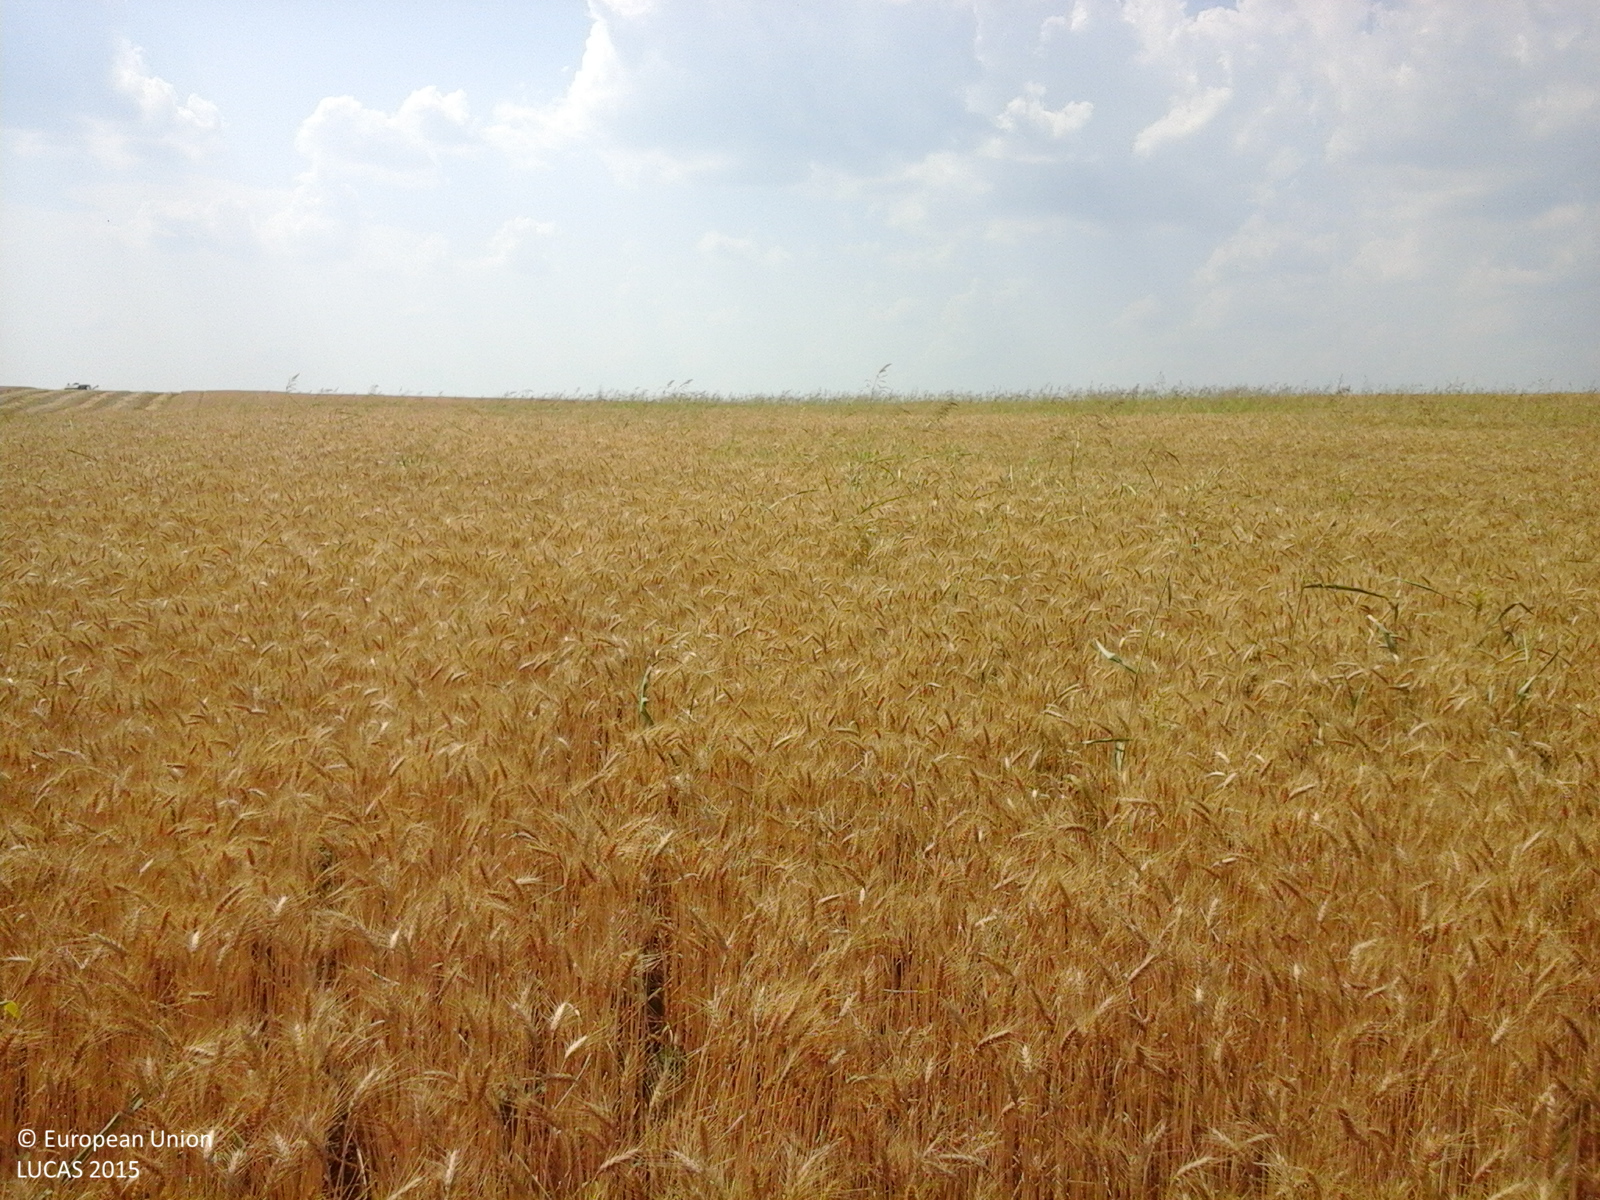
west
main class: Cropland
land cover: Durum wheat
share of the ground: > 75 %
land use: Agriculture (excluding fallow land and kitchen gardens)
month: July
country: RO
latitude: 45.9265
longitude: 28.0343
